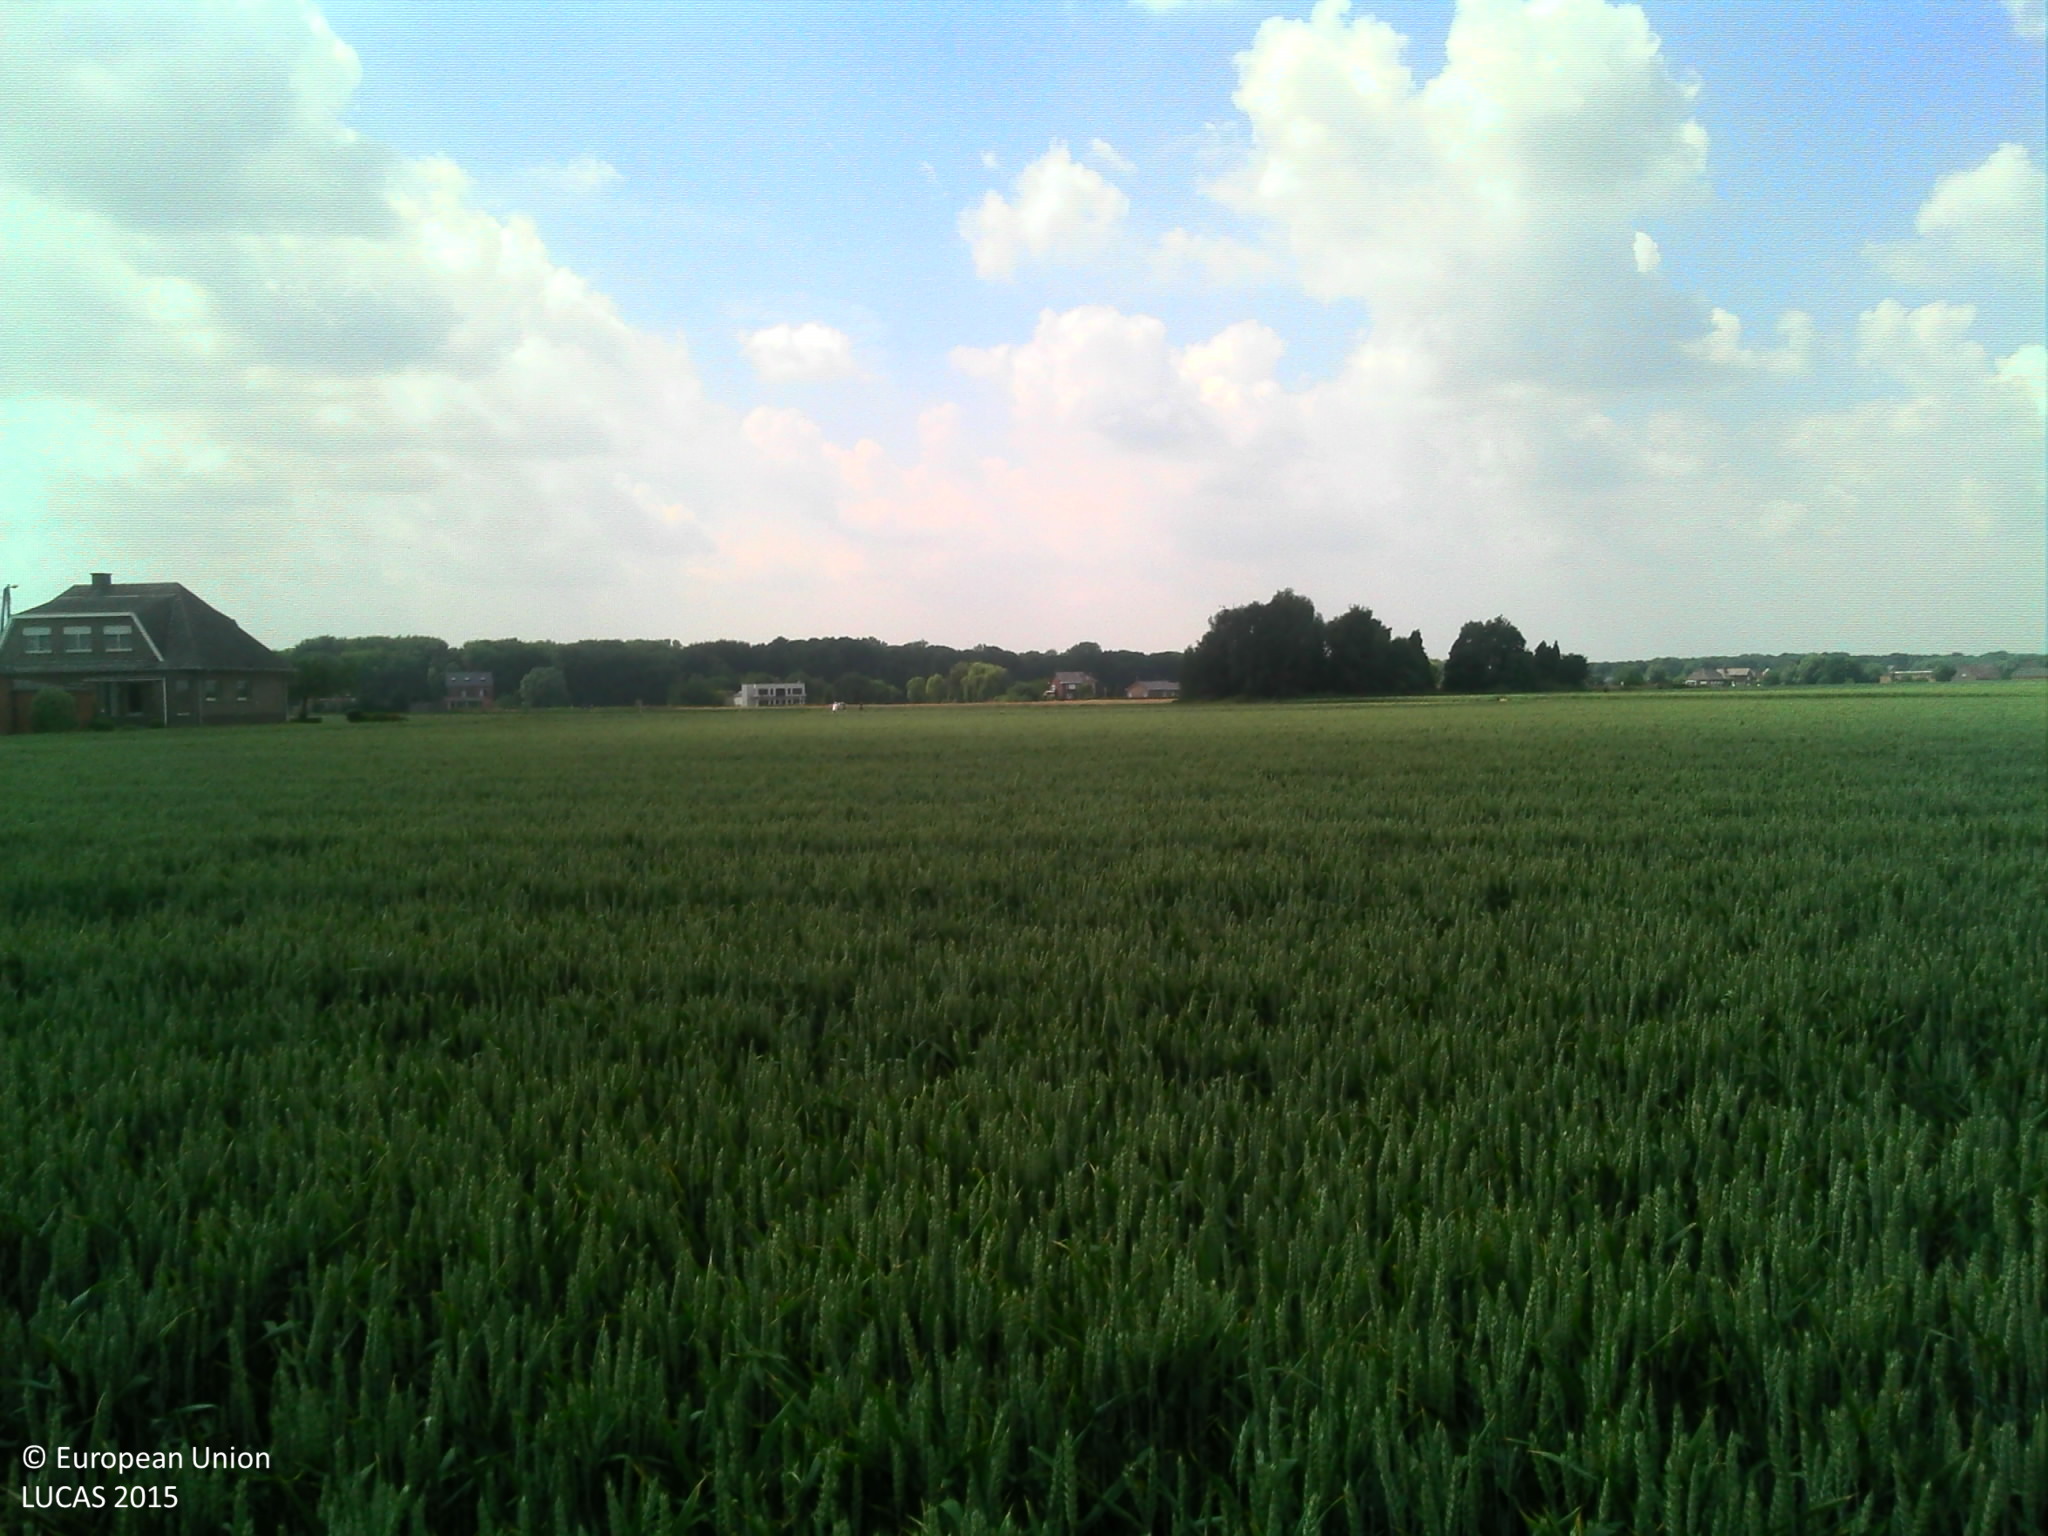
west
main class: Cropland
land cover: Common wheat
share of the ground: > 75 %
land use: Agriculture (excluding fallow land and kitchen gardens)
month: June
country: BE
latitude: 50.9368
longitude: 4.5457
